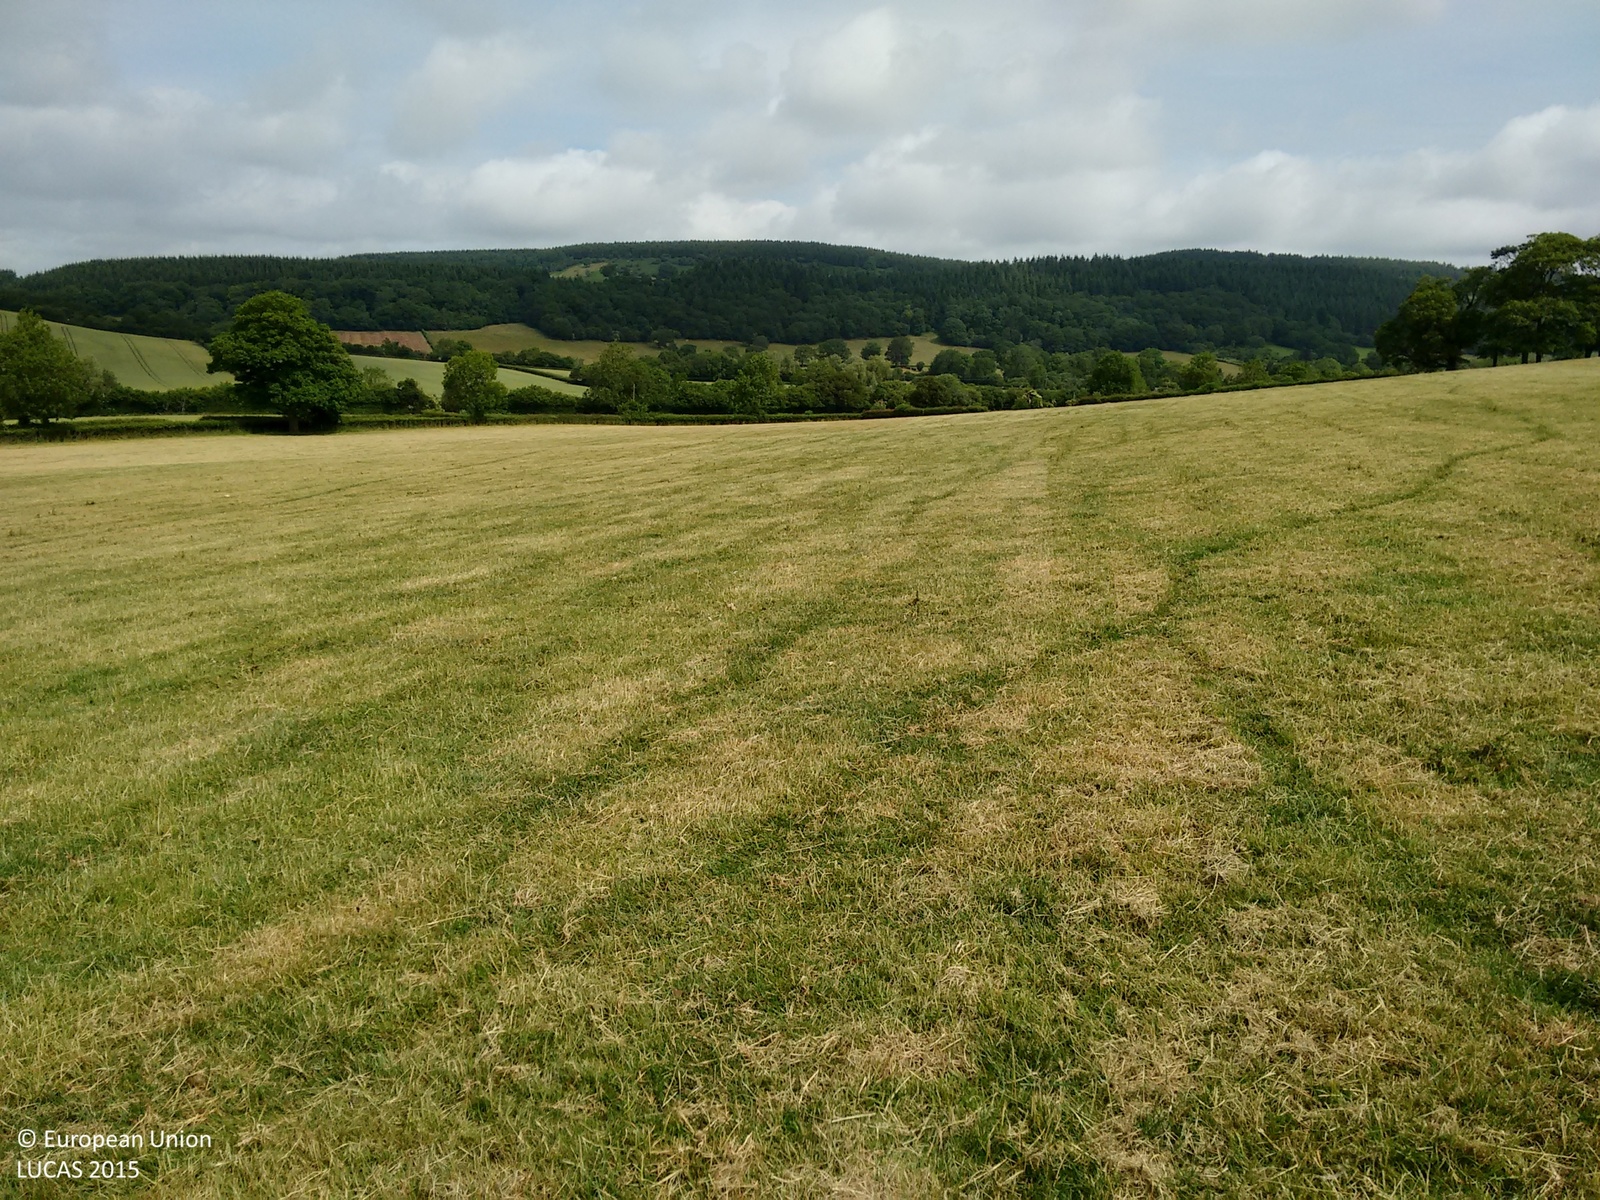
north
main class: Grassland
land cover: Grassland without tree/shrub cover
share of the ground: > 75 %
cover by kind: herbaceous plants 100 %
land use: Agriculture (excluding fallow land and kitchen gardens)
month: June
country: GB
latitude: 52.3370
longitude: -2.7959
